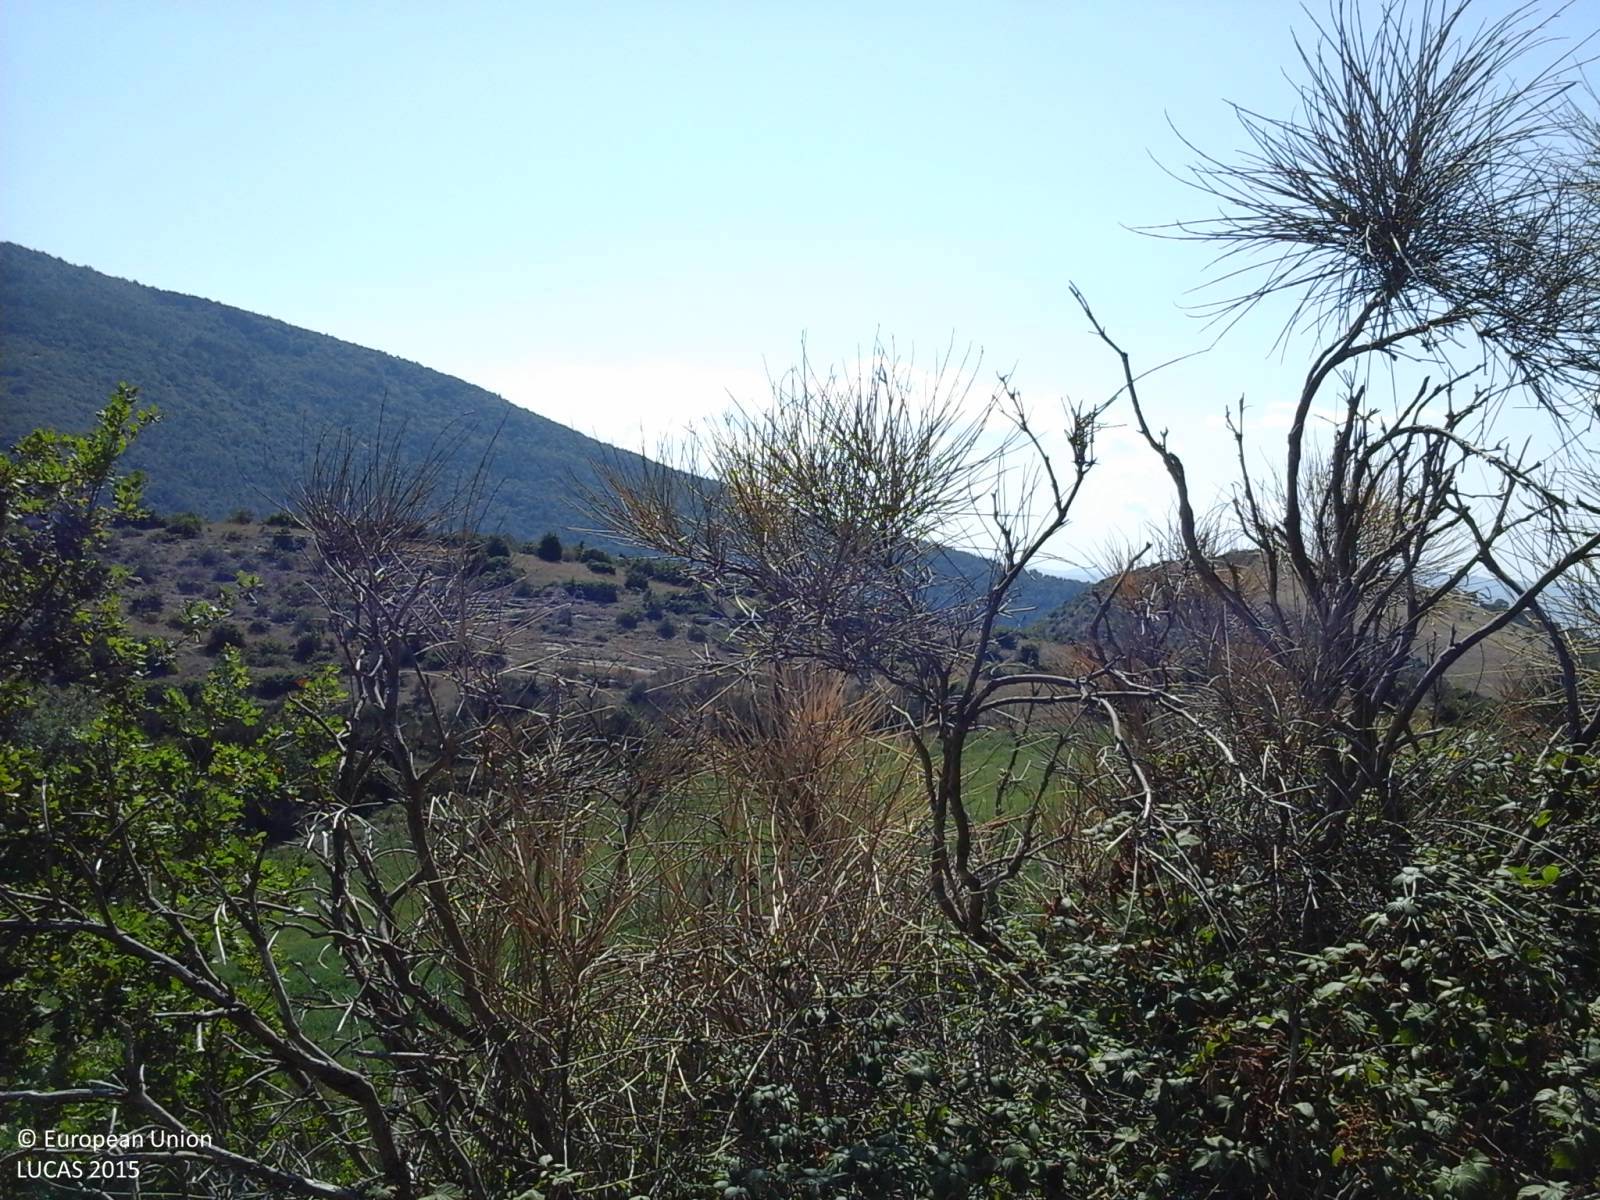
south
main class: Shrubland
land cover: Shrubland with sparse tree cover
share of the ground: > 75 %
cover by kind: shrubs 75 %, herbaceous plants 20 %, broadleaved forest trees 5 %
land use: Semi-natural and natural areas not in use
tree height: < 5 m
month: September
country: IT
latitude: 43.0895
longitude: 12.6336
